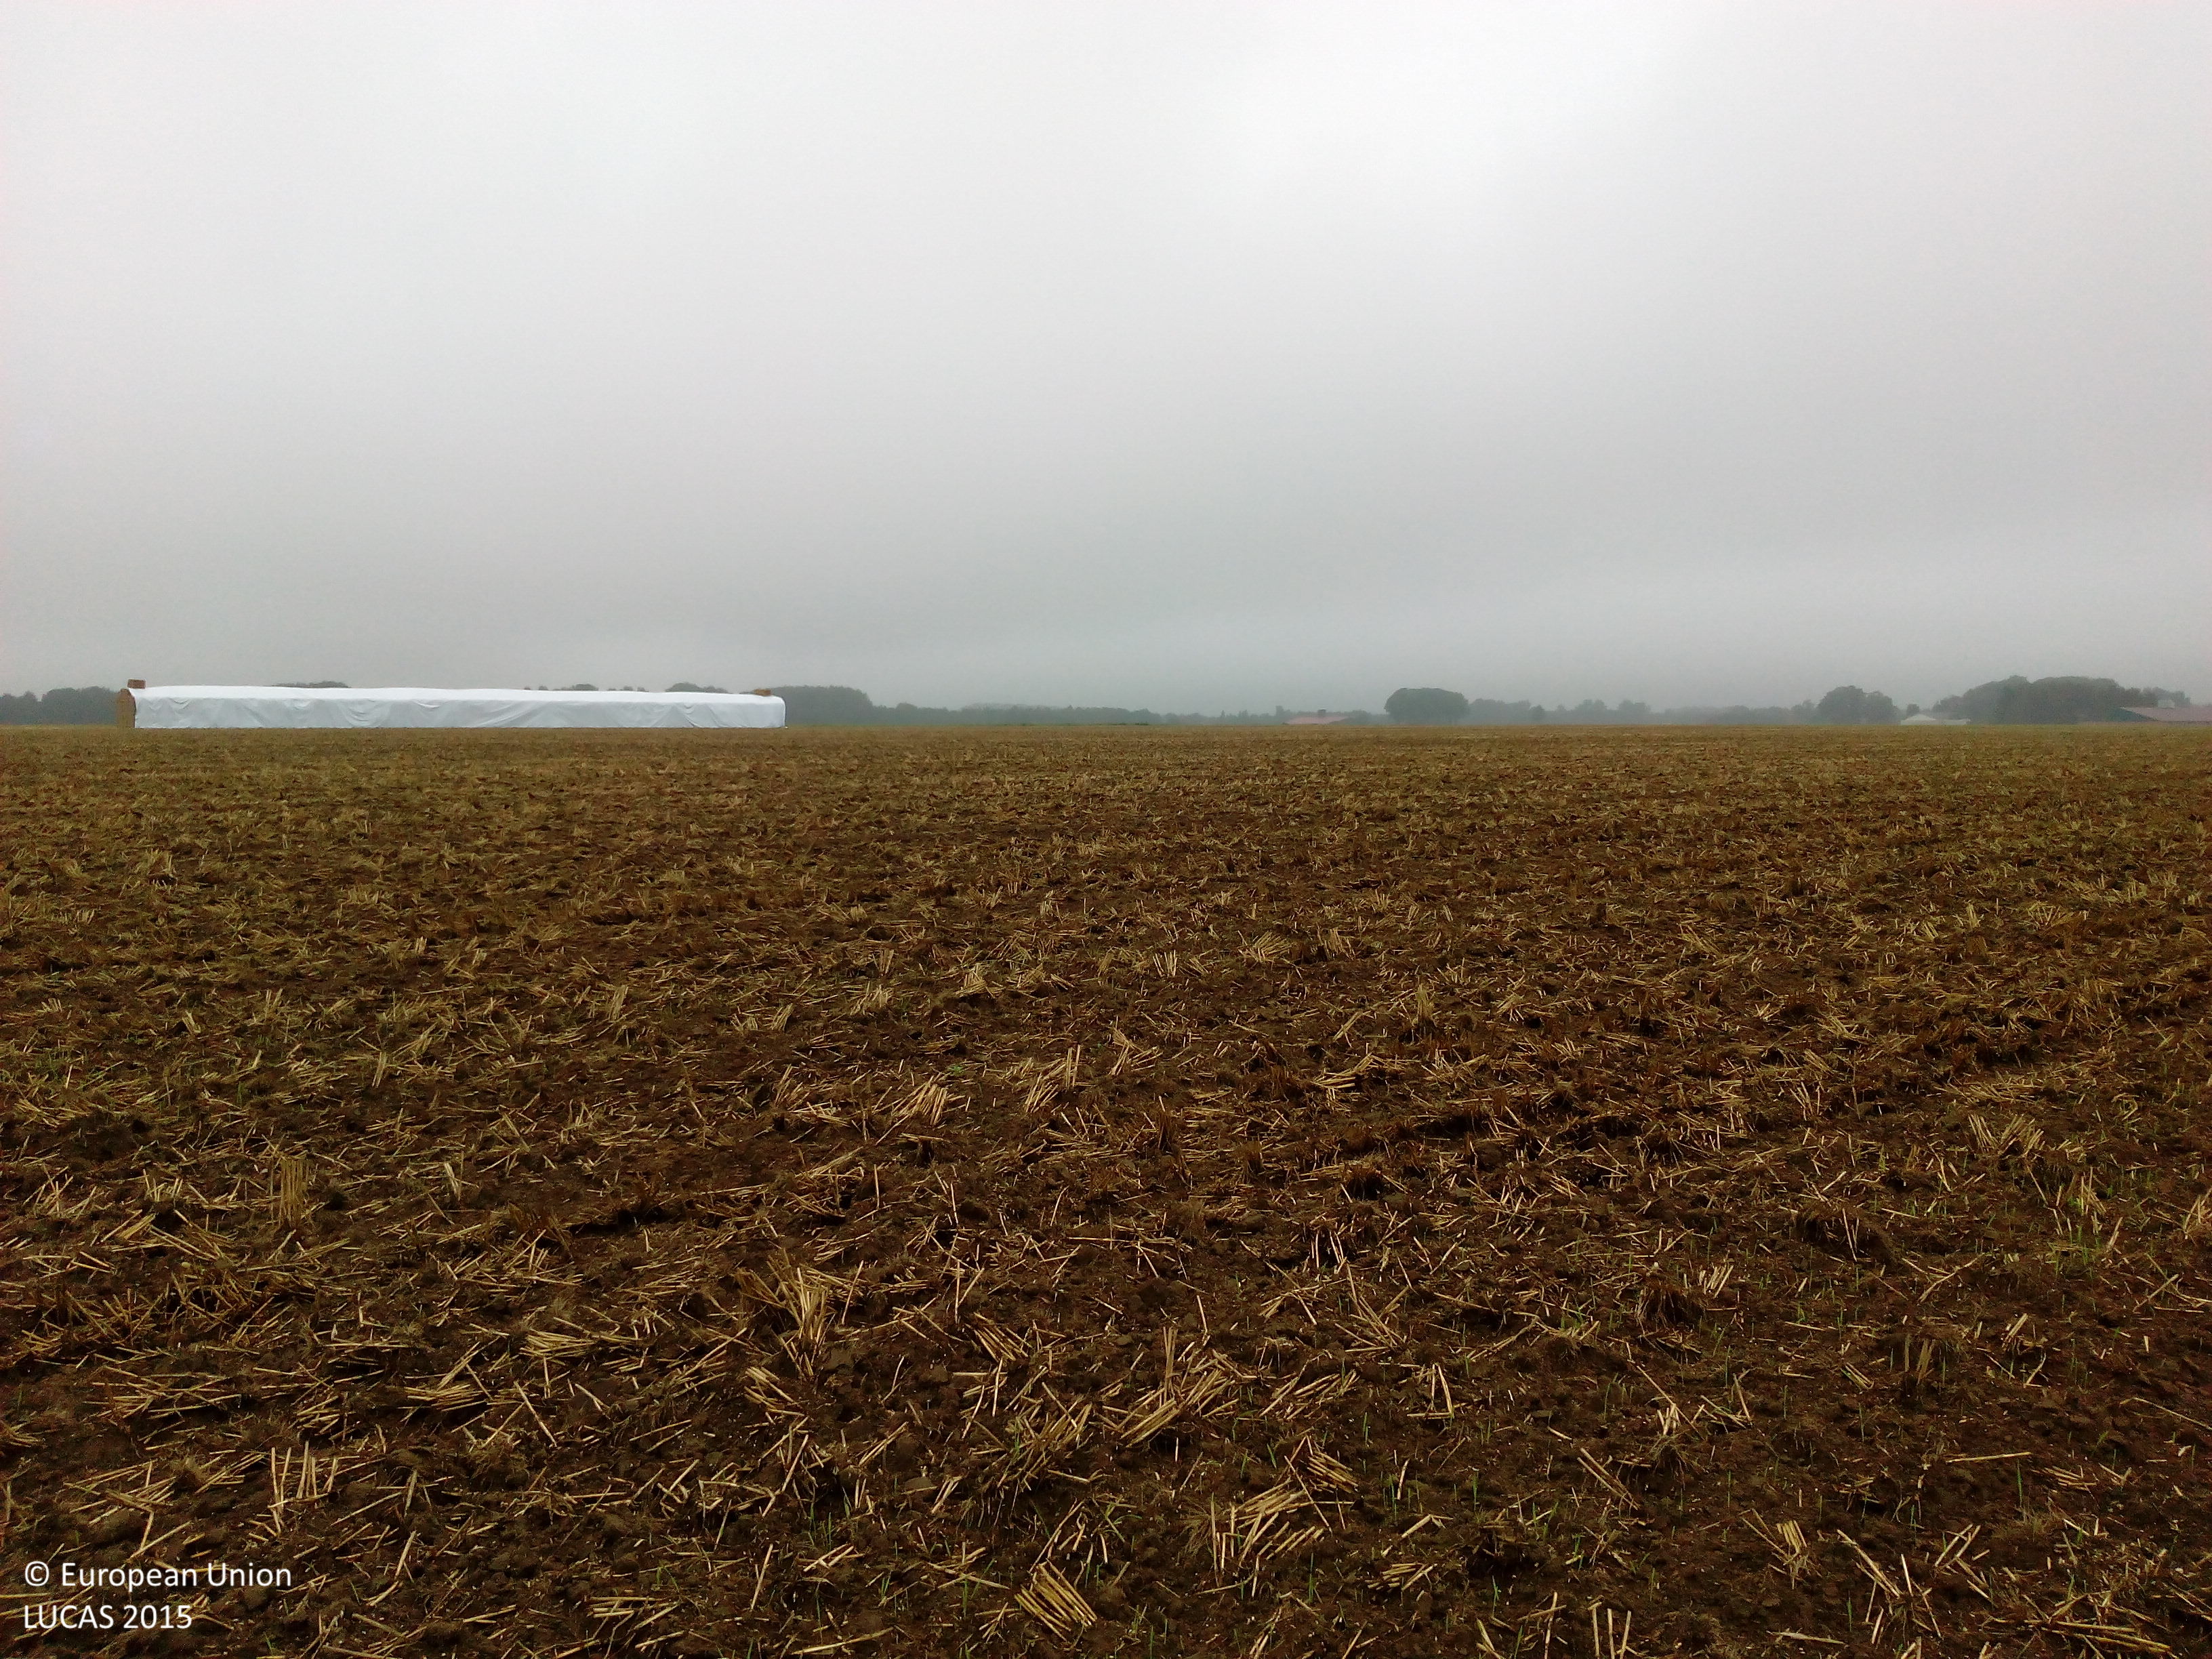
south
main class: Cropland
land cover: Common wheat
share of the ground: < 10 %
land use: Agriculture (excluding fallow land and kitchen gardens)
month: August
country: DE
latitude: 52.7998
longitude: 8.5321
